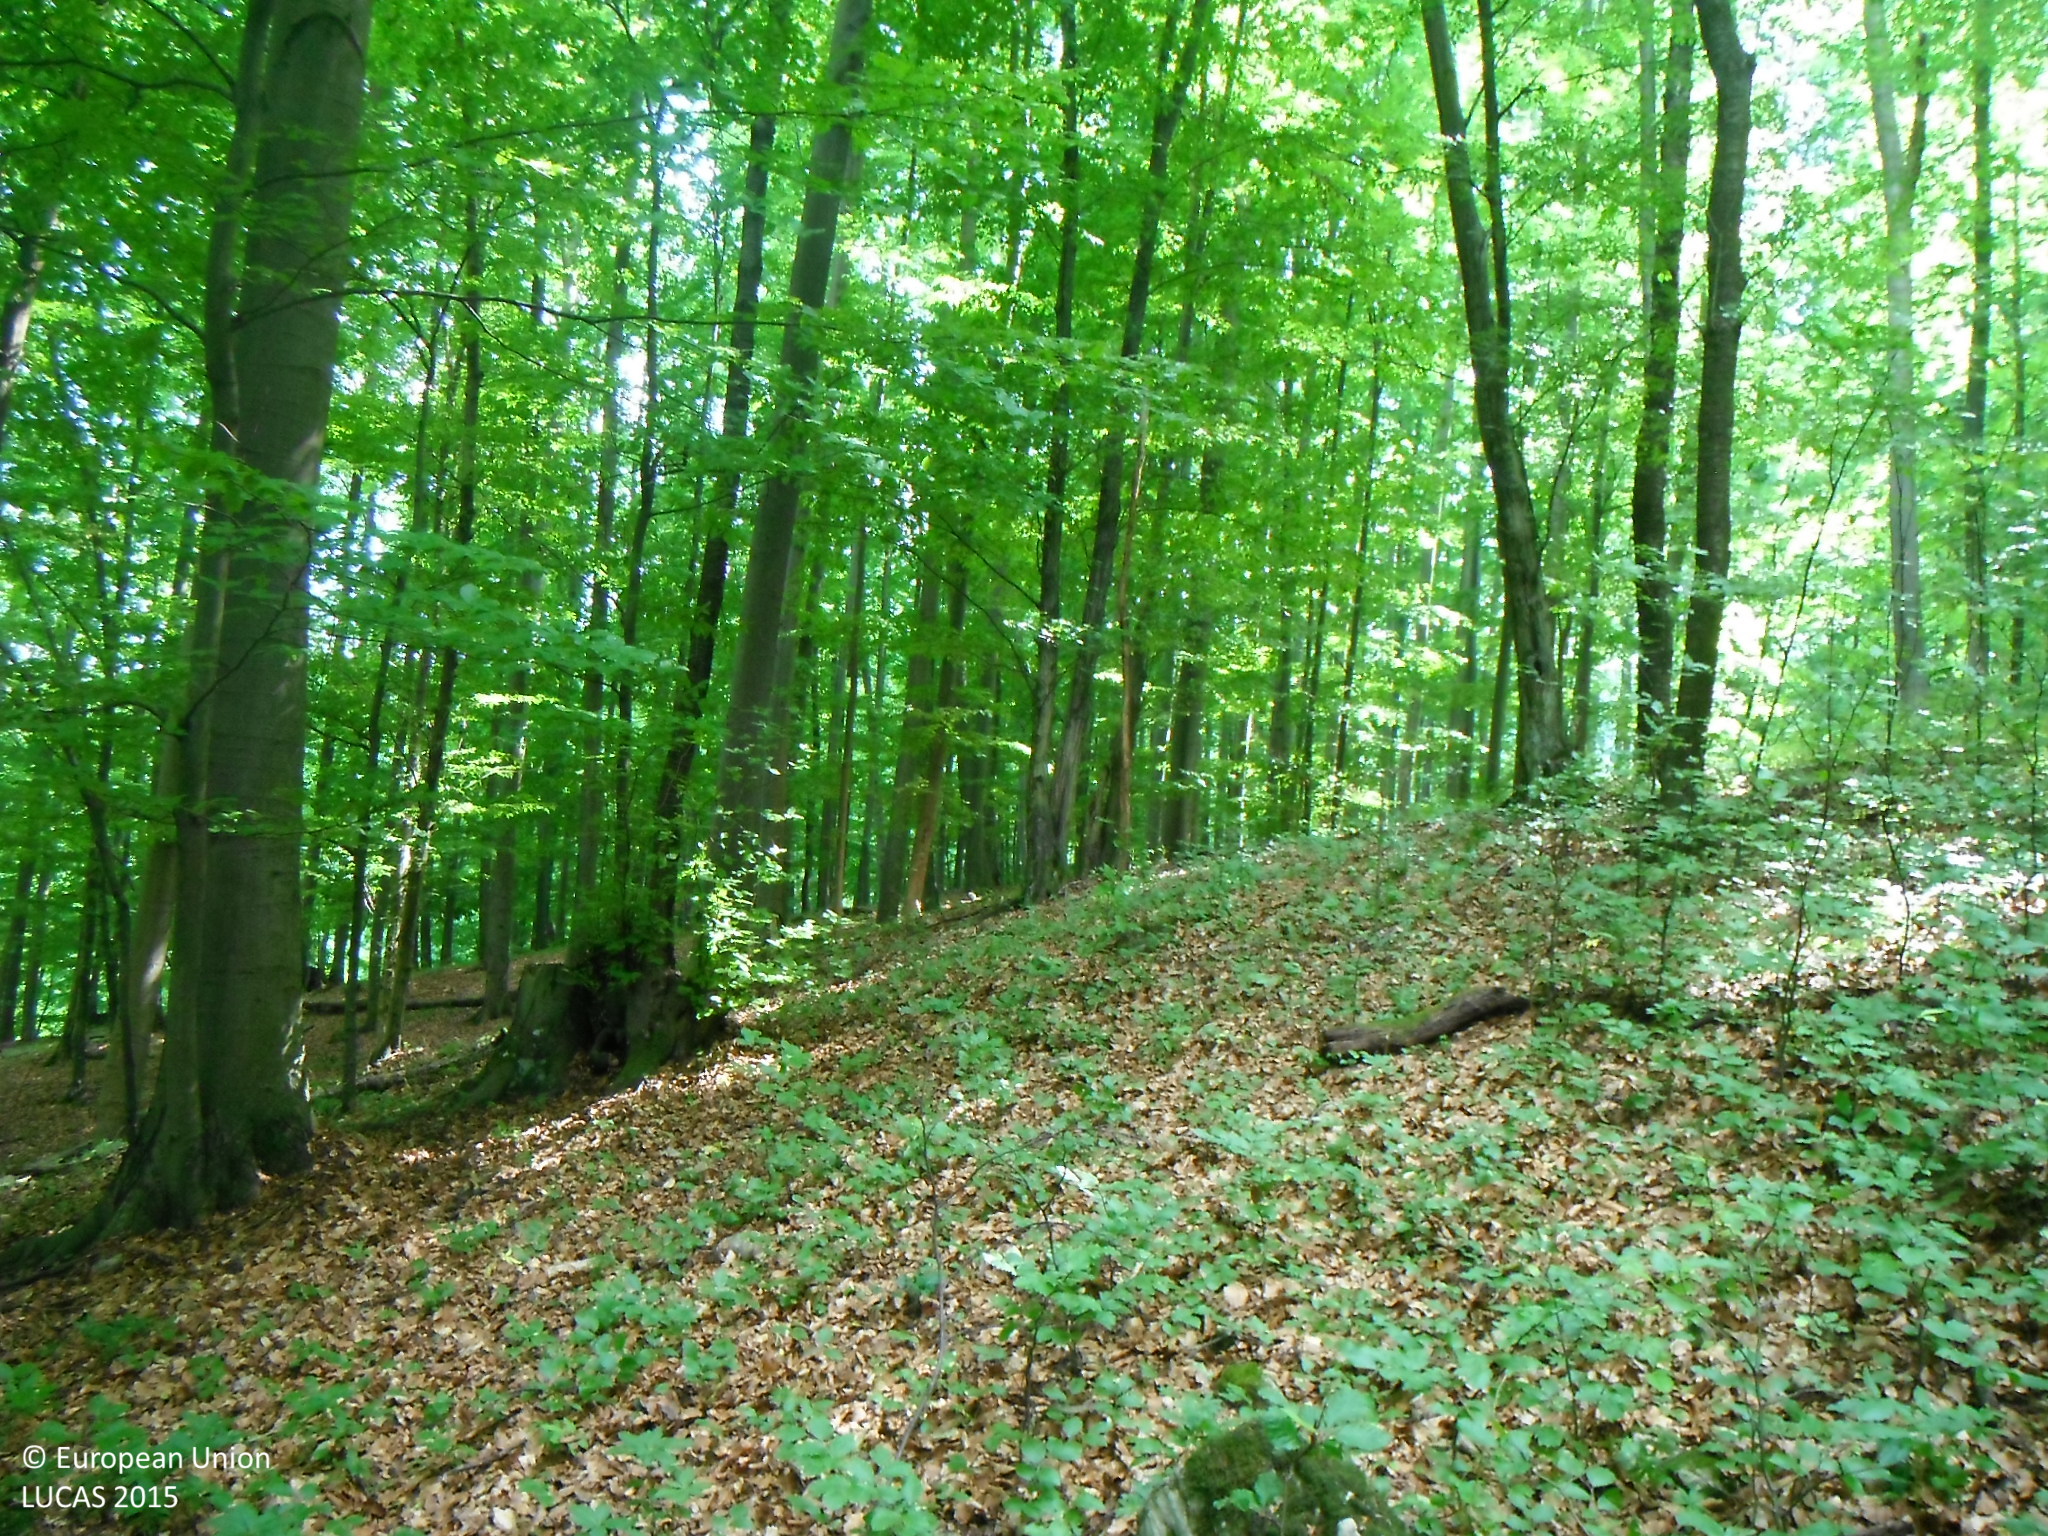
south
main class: Woodland
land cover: Broadleaved woodland
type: beech forest
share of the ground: > 75 %
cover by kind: broadleaved forest trees 95 %, herbaceous plants 5 %
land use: Forestry
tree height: > 5 m
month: June
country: SK
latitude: 48.4084
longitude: 19.5219
